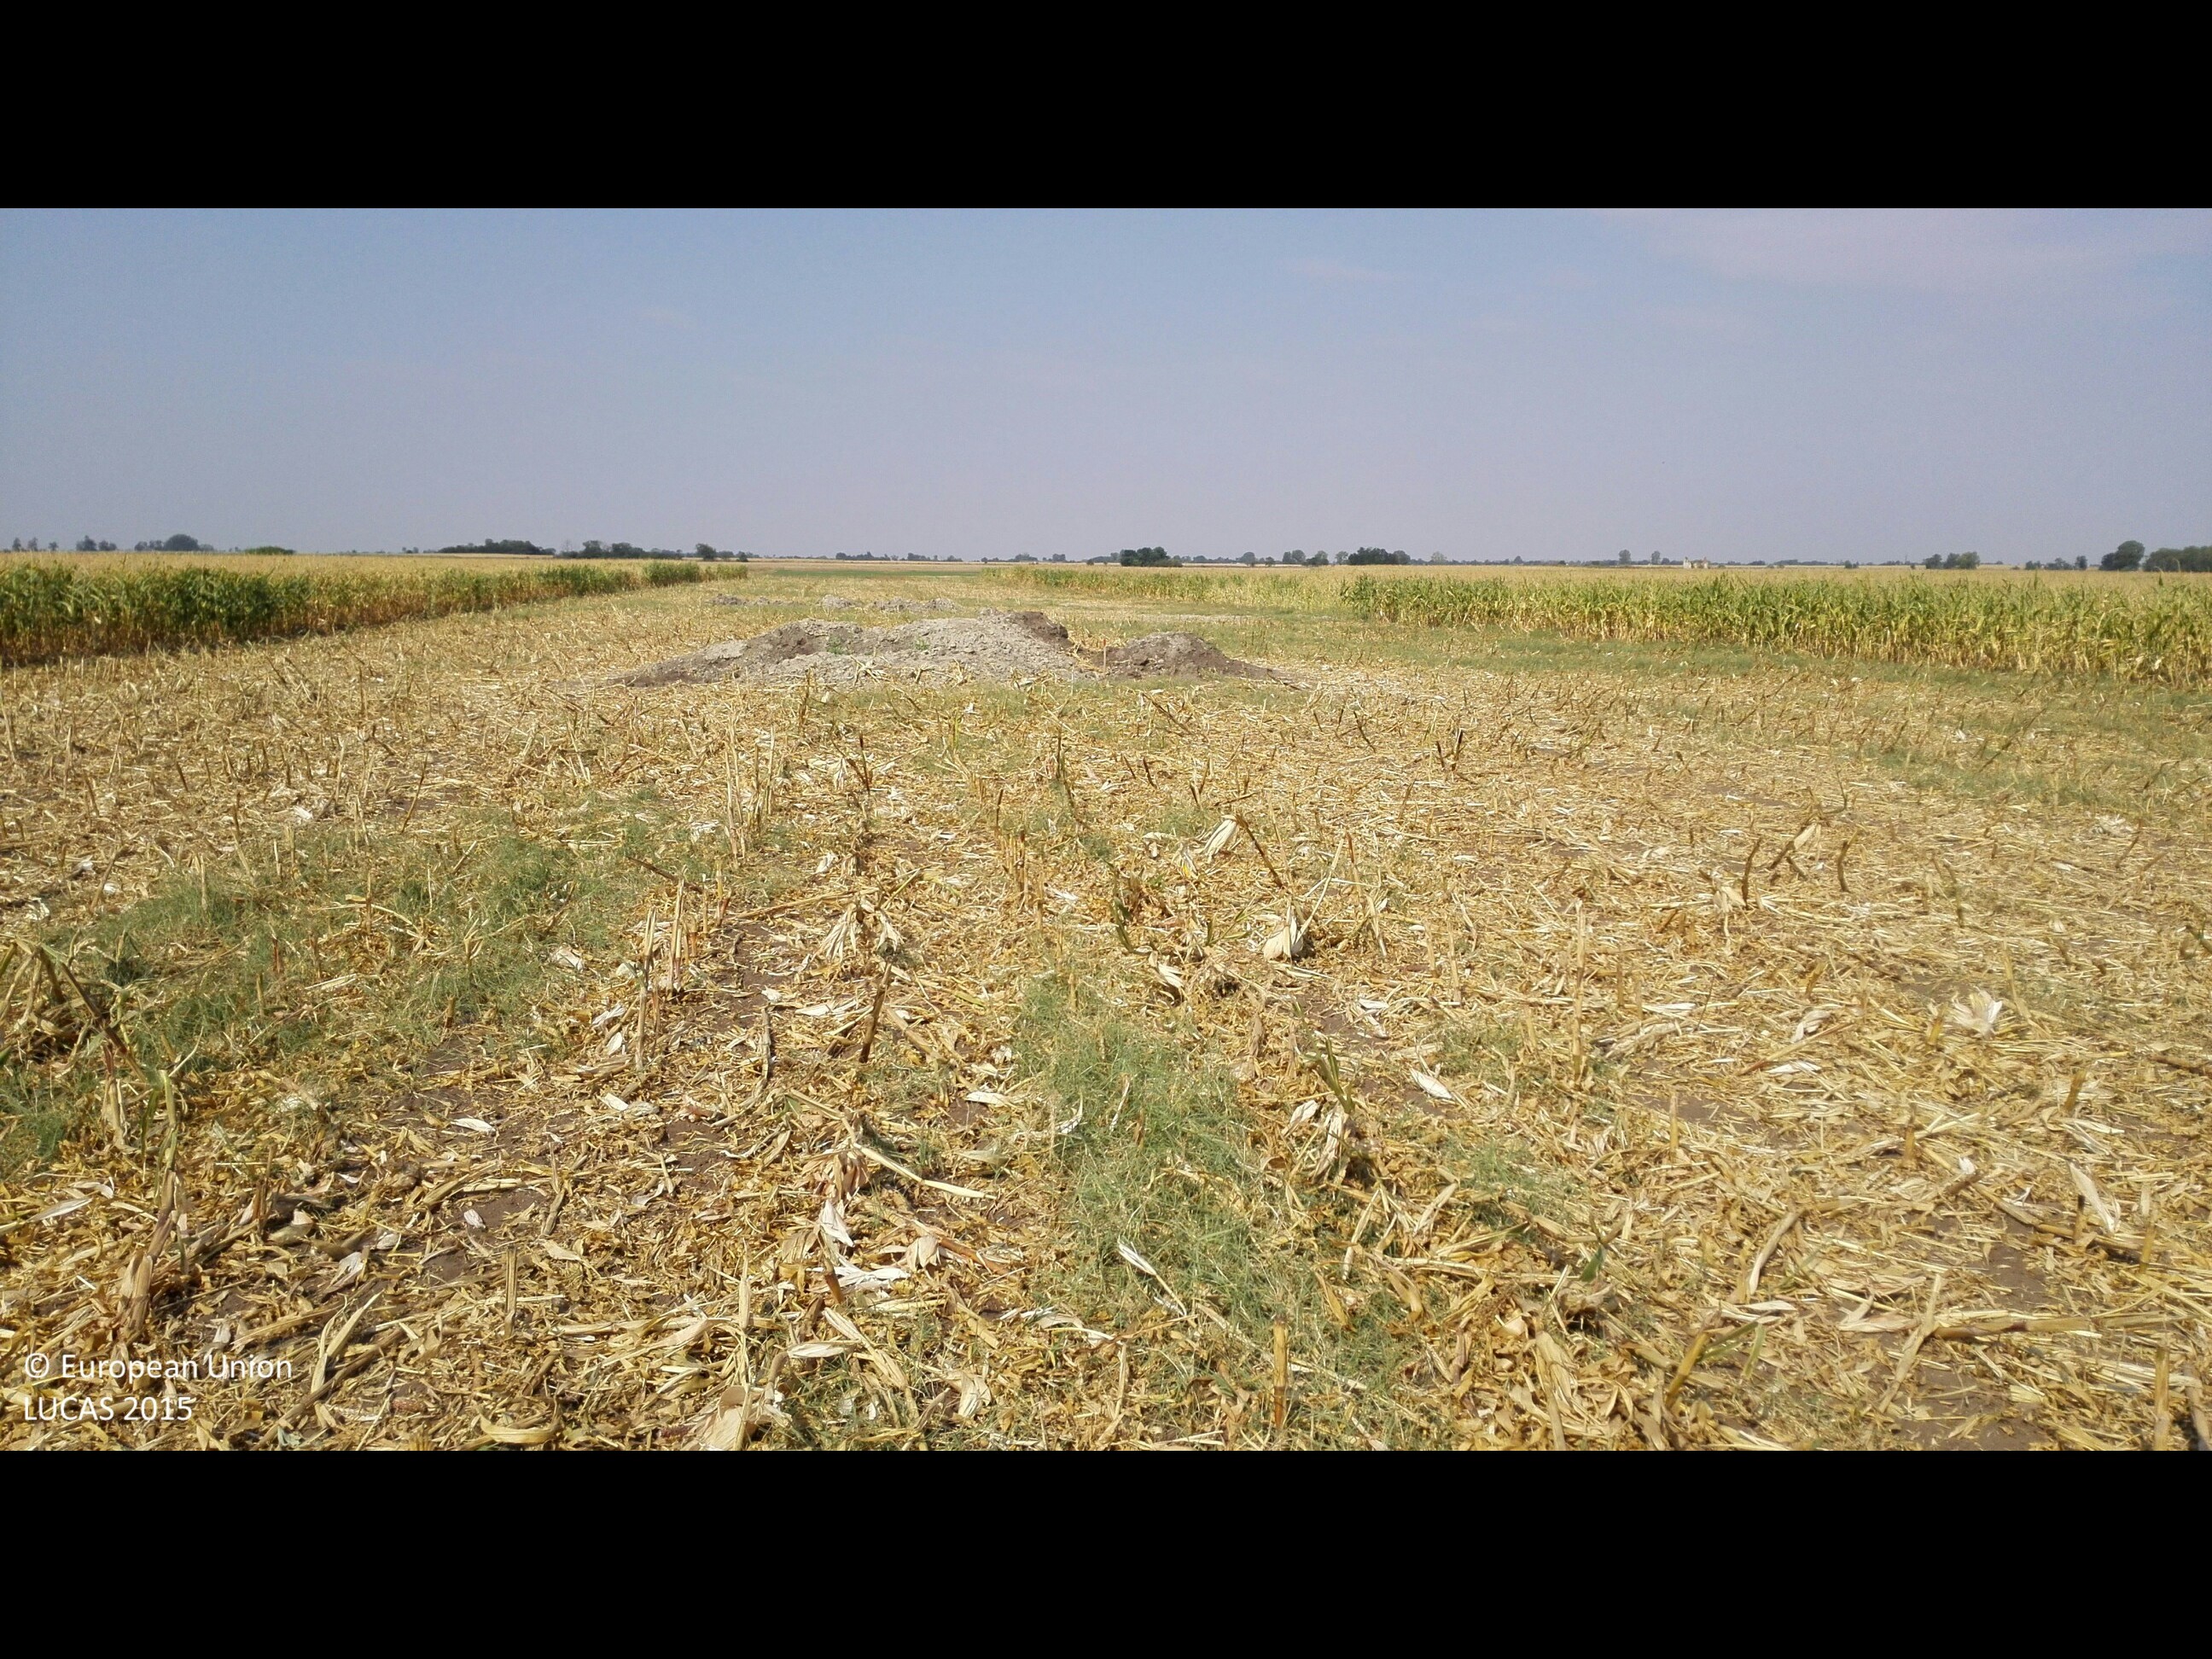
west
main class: Cropland
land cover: Maize
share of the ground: 10 - 25 %
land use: Agriculture (excluding fallow land and kitchen gardens)
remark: Harvested field
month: August
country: HU
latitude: 47.4607
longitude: 21.6249
